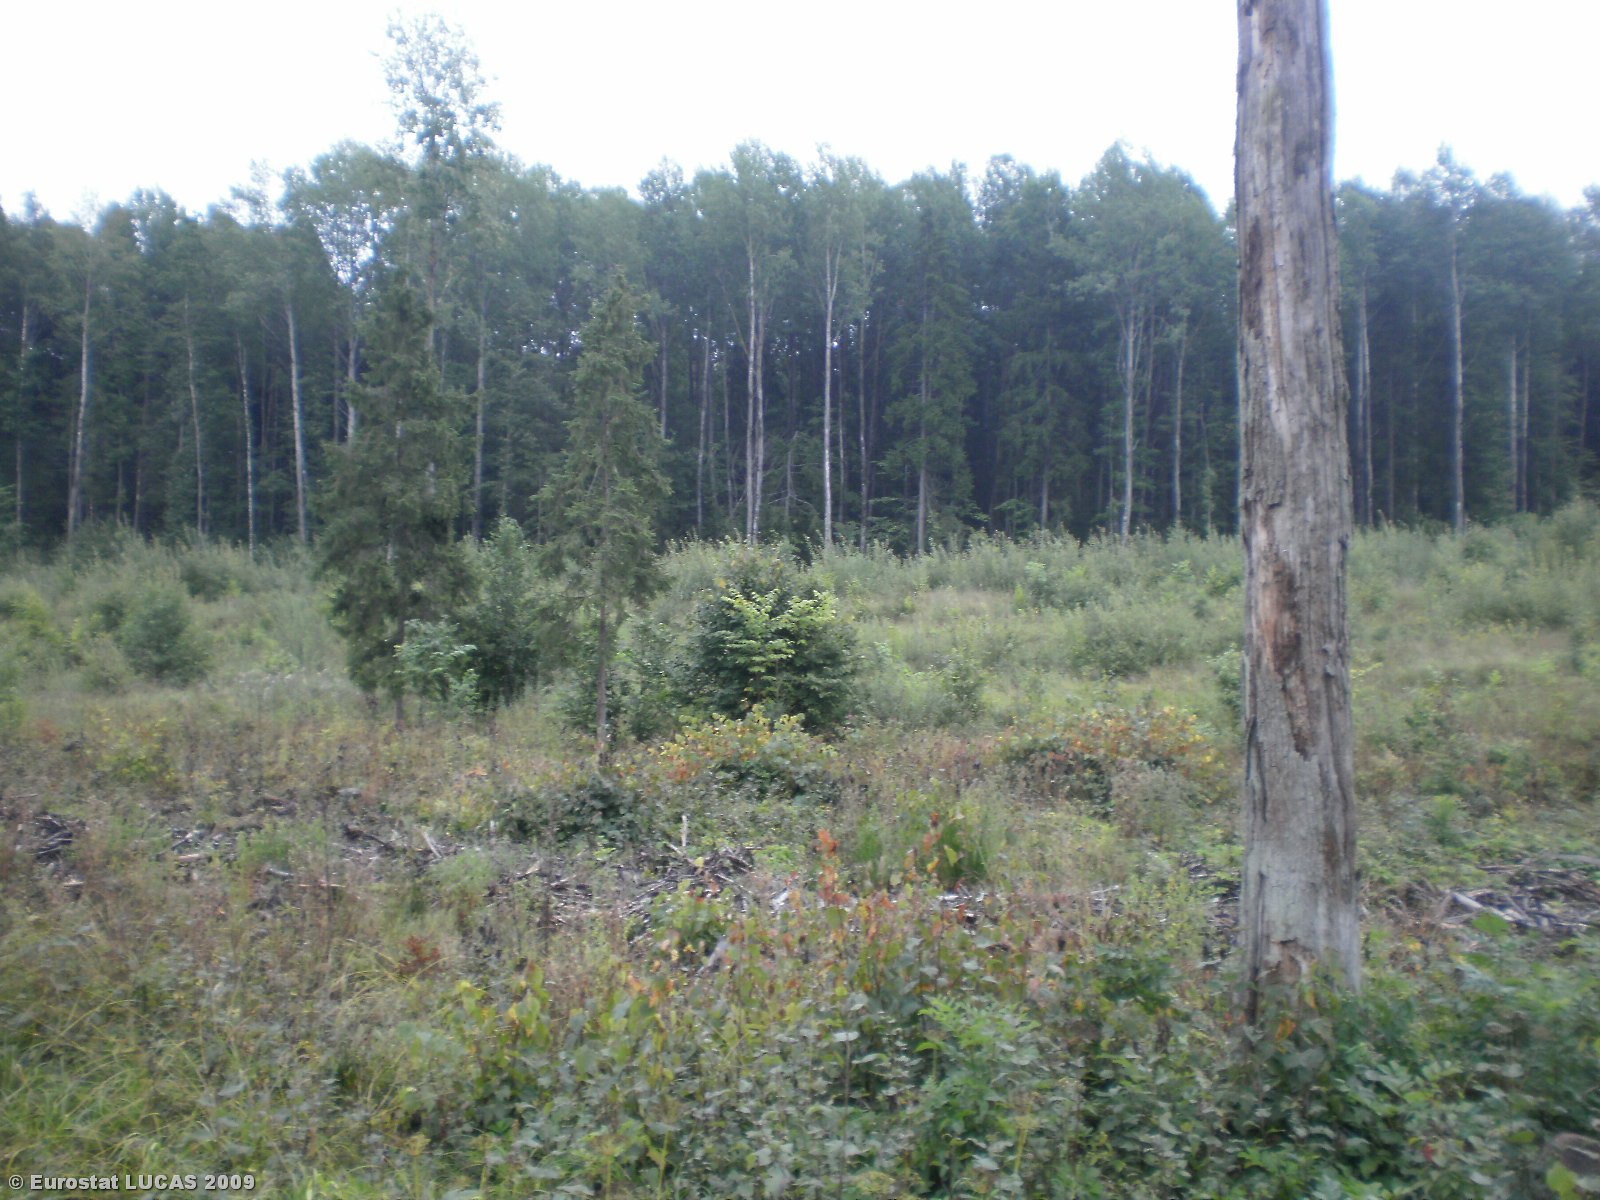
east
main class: Shrubland
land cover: Shrubland with sparse tree cover
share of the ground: > 75 %
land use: Forestry
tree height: > 5 m
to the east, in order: Shrubland with sparse tree cover; Broadleaved woodland; Tracks; Broadleaved woodland; Mixed woodland
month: August
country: LT
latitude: 55.1414
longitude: 25.3874
